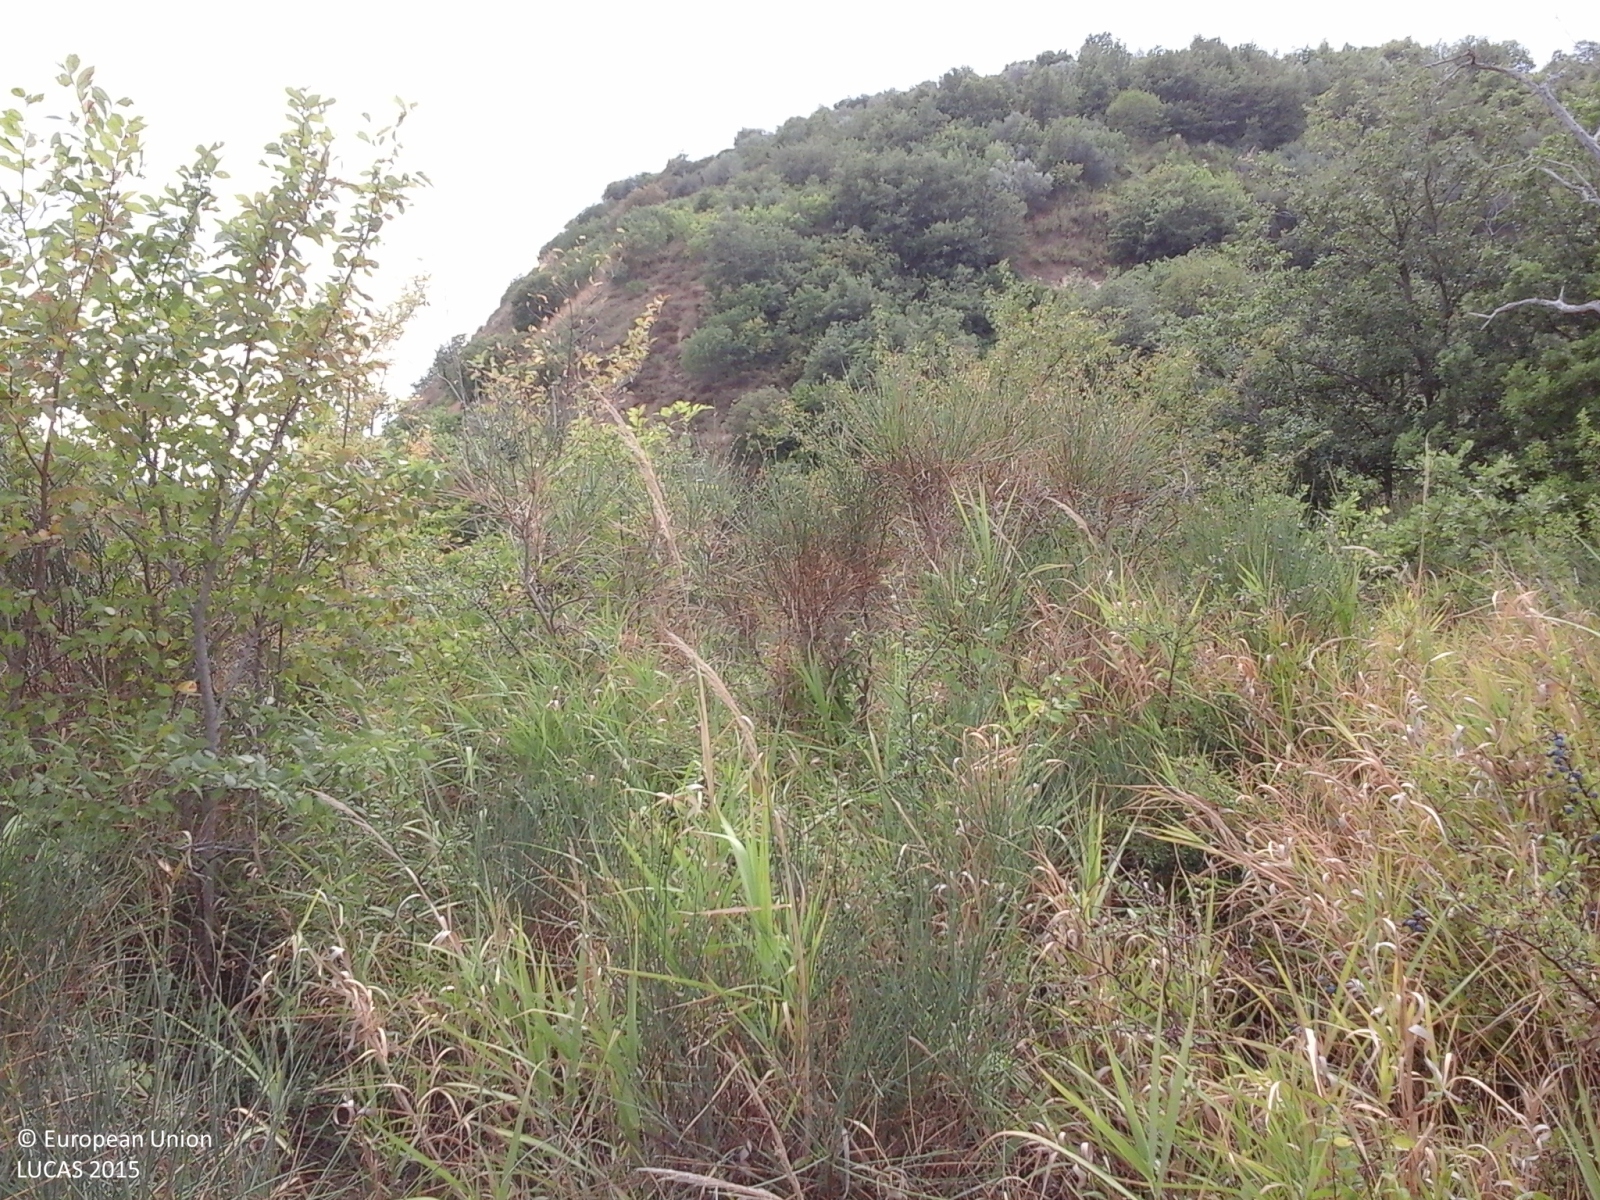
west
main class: Shrubland
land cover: Shrubland with sparse tree cover
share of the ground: > 75 %
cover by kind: shrubs 95 %, broadleaved forest trees 5 %
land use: Abandoned areas
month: July
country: IT
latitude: 41.7471
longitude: 14.7343
